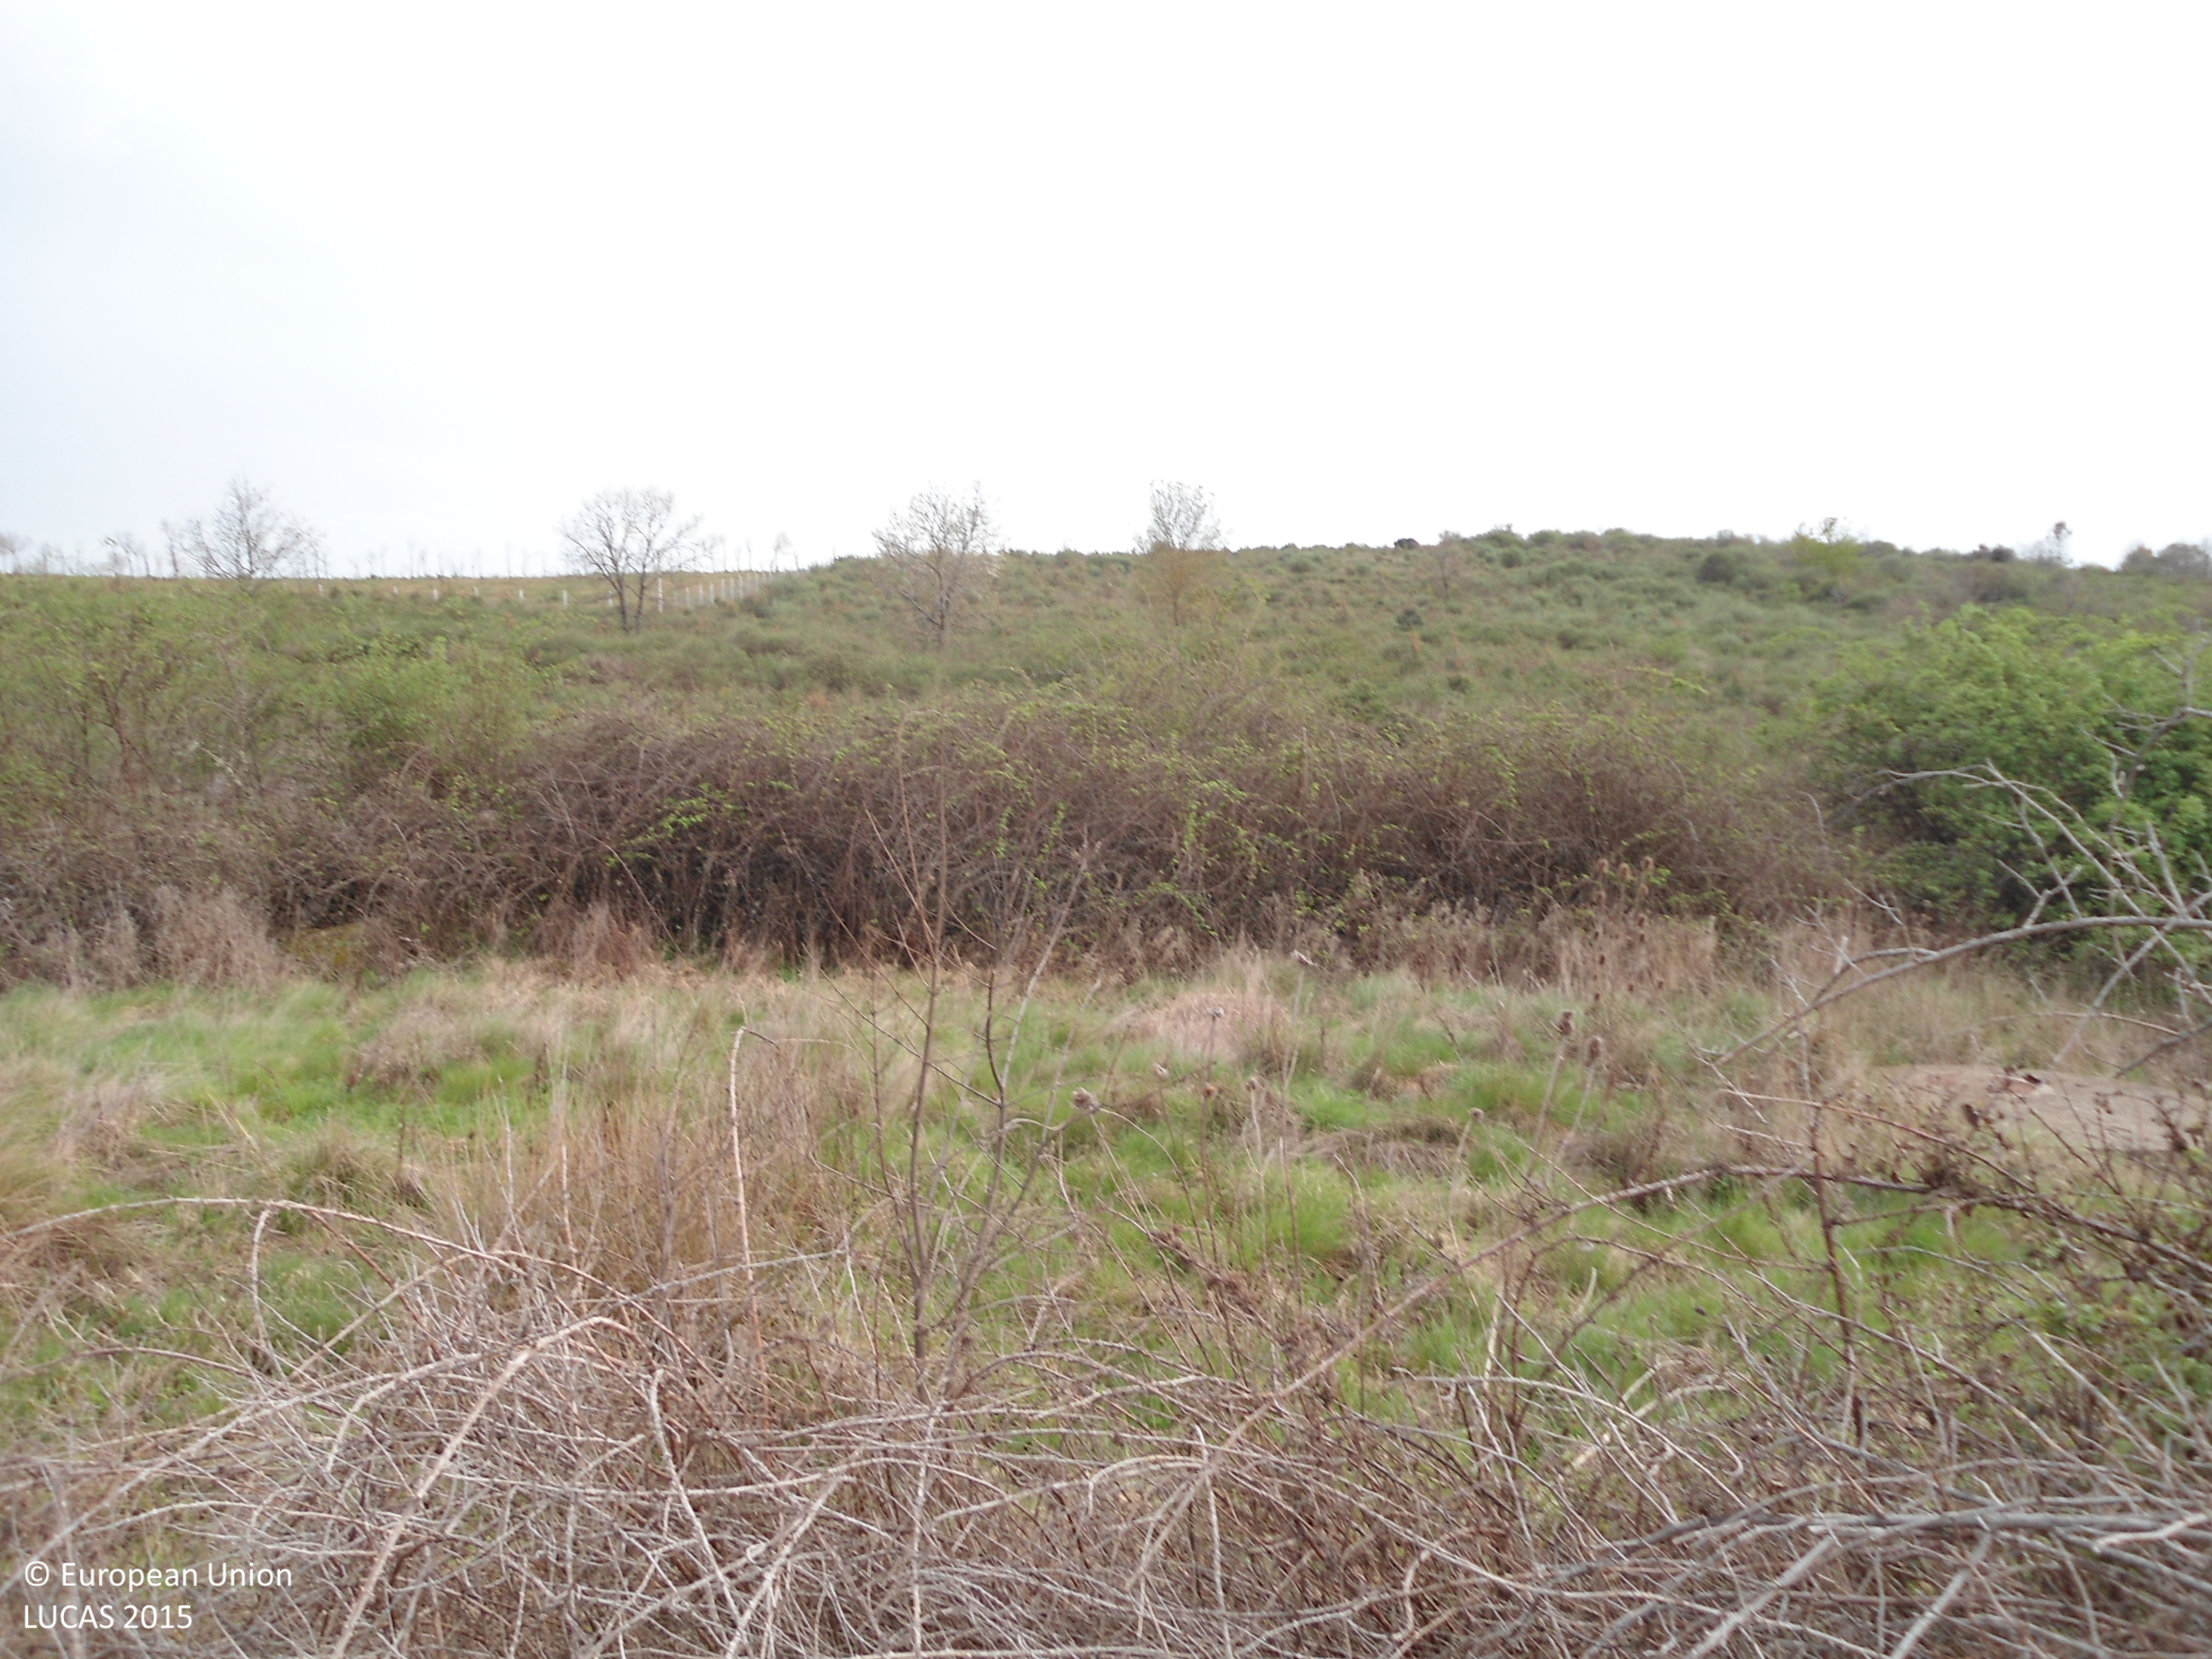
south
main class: Grassland
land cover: Grassland without tree/shrub cover
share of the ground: > 75 %
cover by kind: herbaceous plants 100 %
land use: Agriculture (excluding fallow land and kitchen gardens)
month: April
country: ES
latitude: 41.7541
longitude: -6.4740
